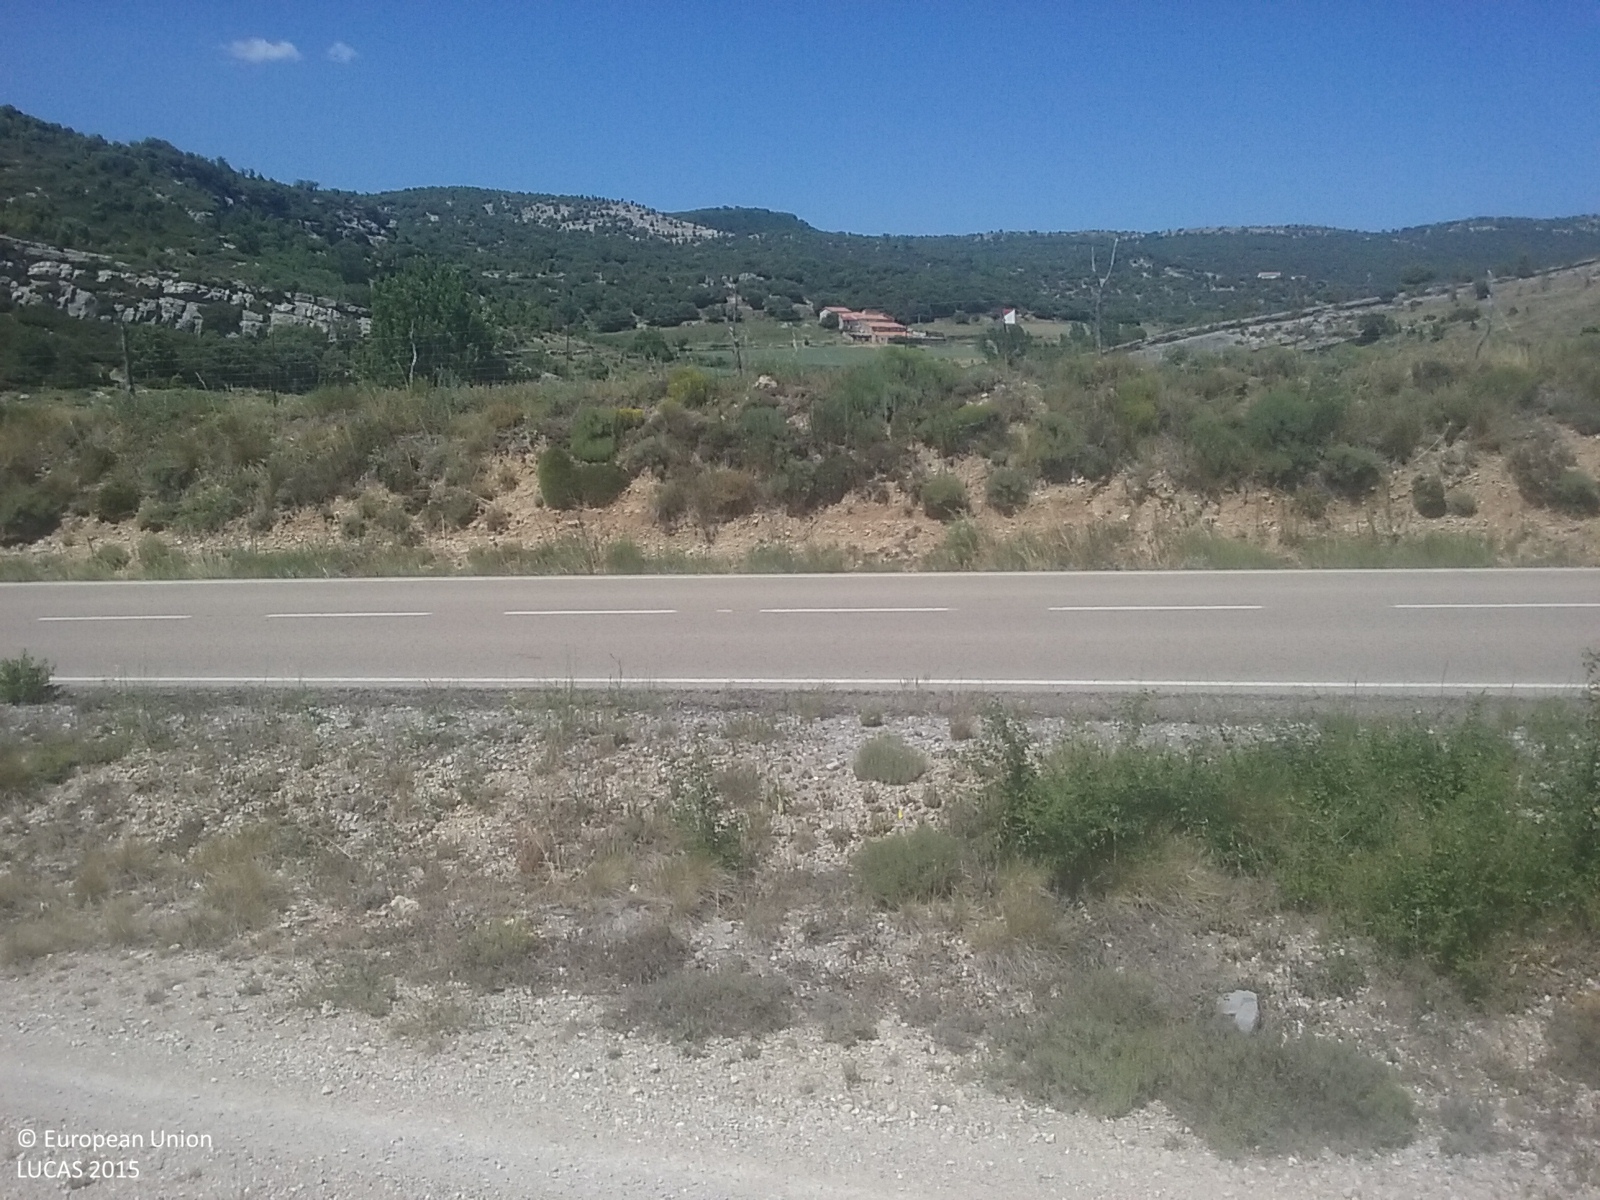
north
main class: Grassland
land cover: Grassland without tree/shrub cover
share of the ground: > 75 %
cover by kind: herbaceous plants 95 %, shrubs 5 %
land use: Agriculture (excluding fallow land and kitchen gardens)
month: June
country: ES
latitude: 40.6047
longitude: -0.0642
